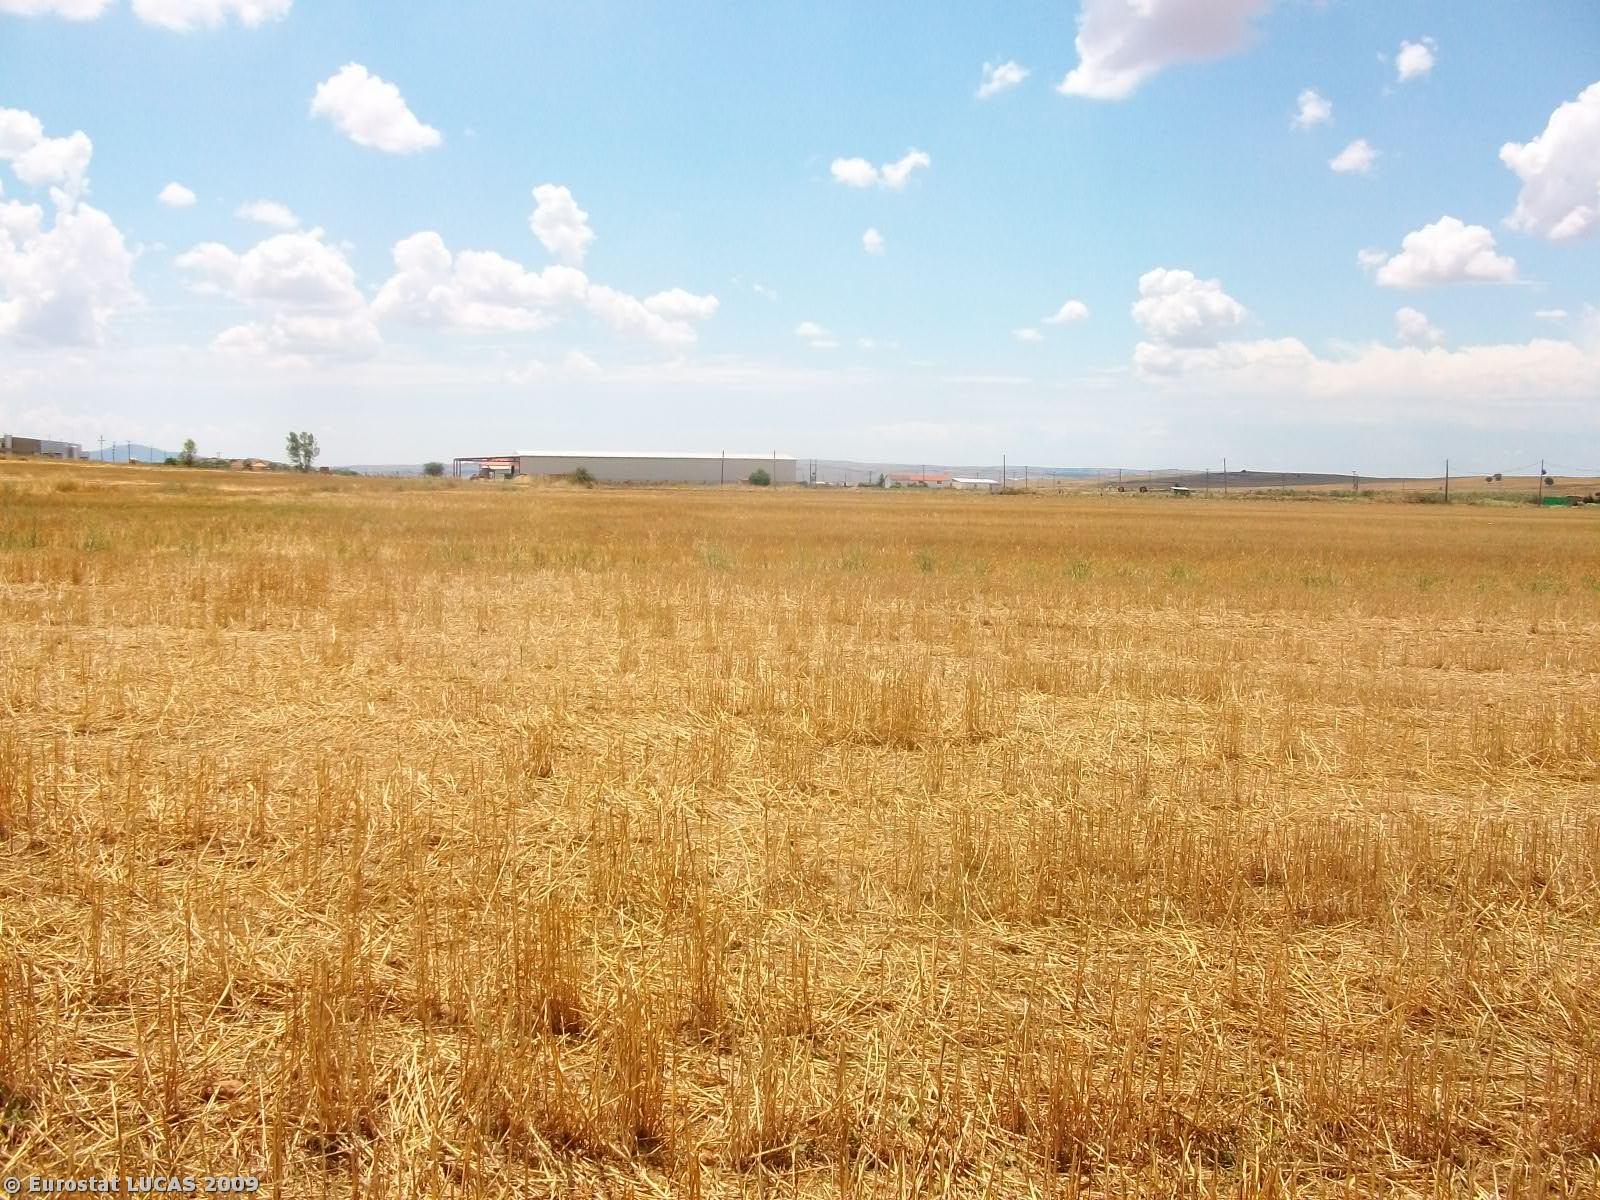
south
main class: Cropland
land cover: Barley
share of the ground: < 10 %
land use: Agriculture (excluding fallow land and kitchen gardens)
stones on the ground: < 10 %
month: June
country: GR
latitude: 40.9132
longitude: 22.7477
